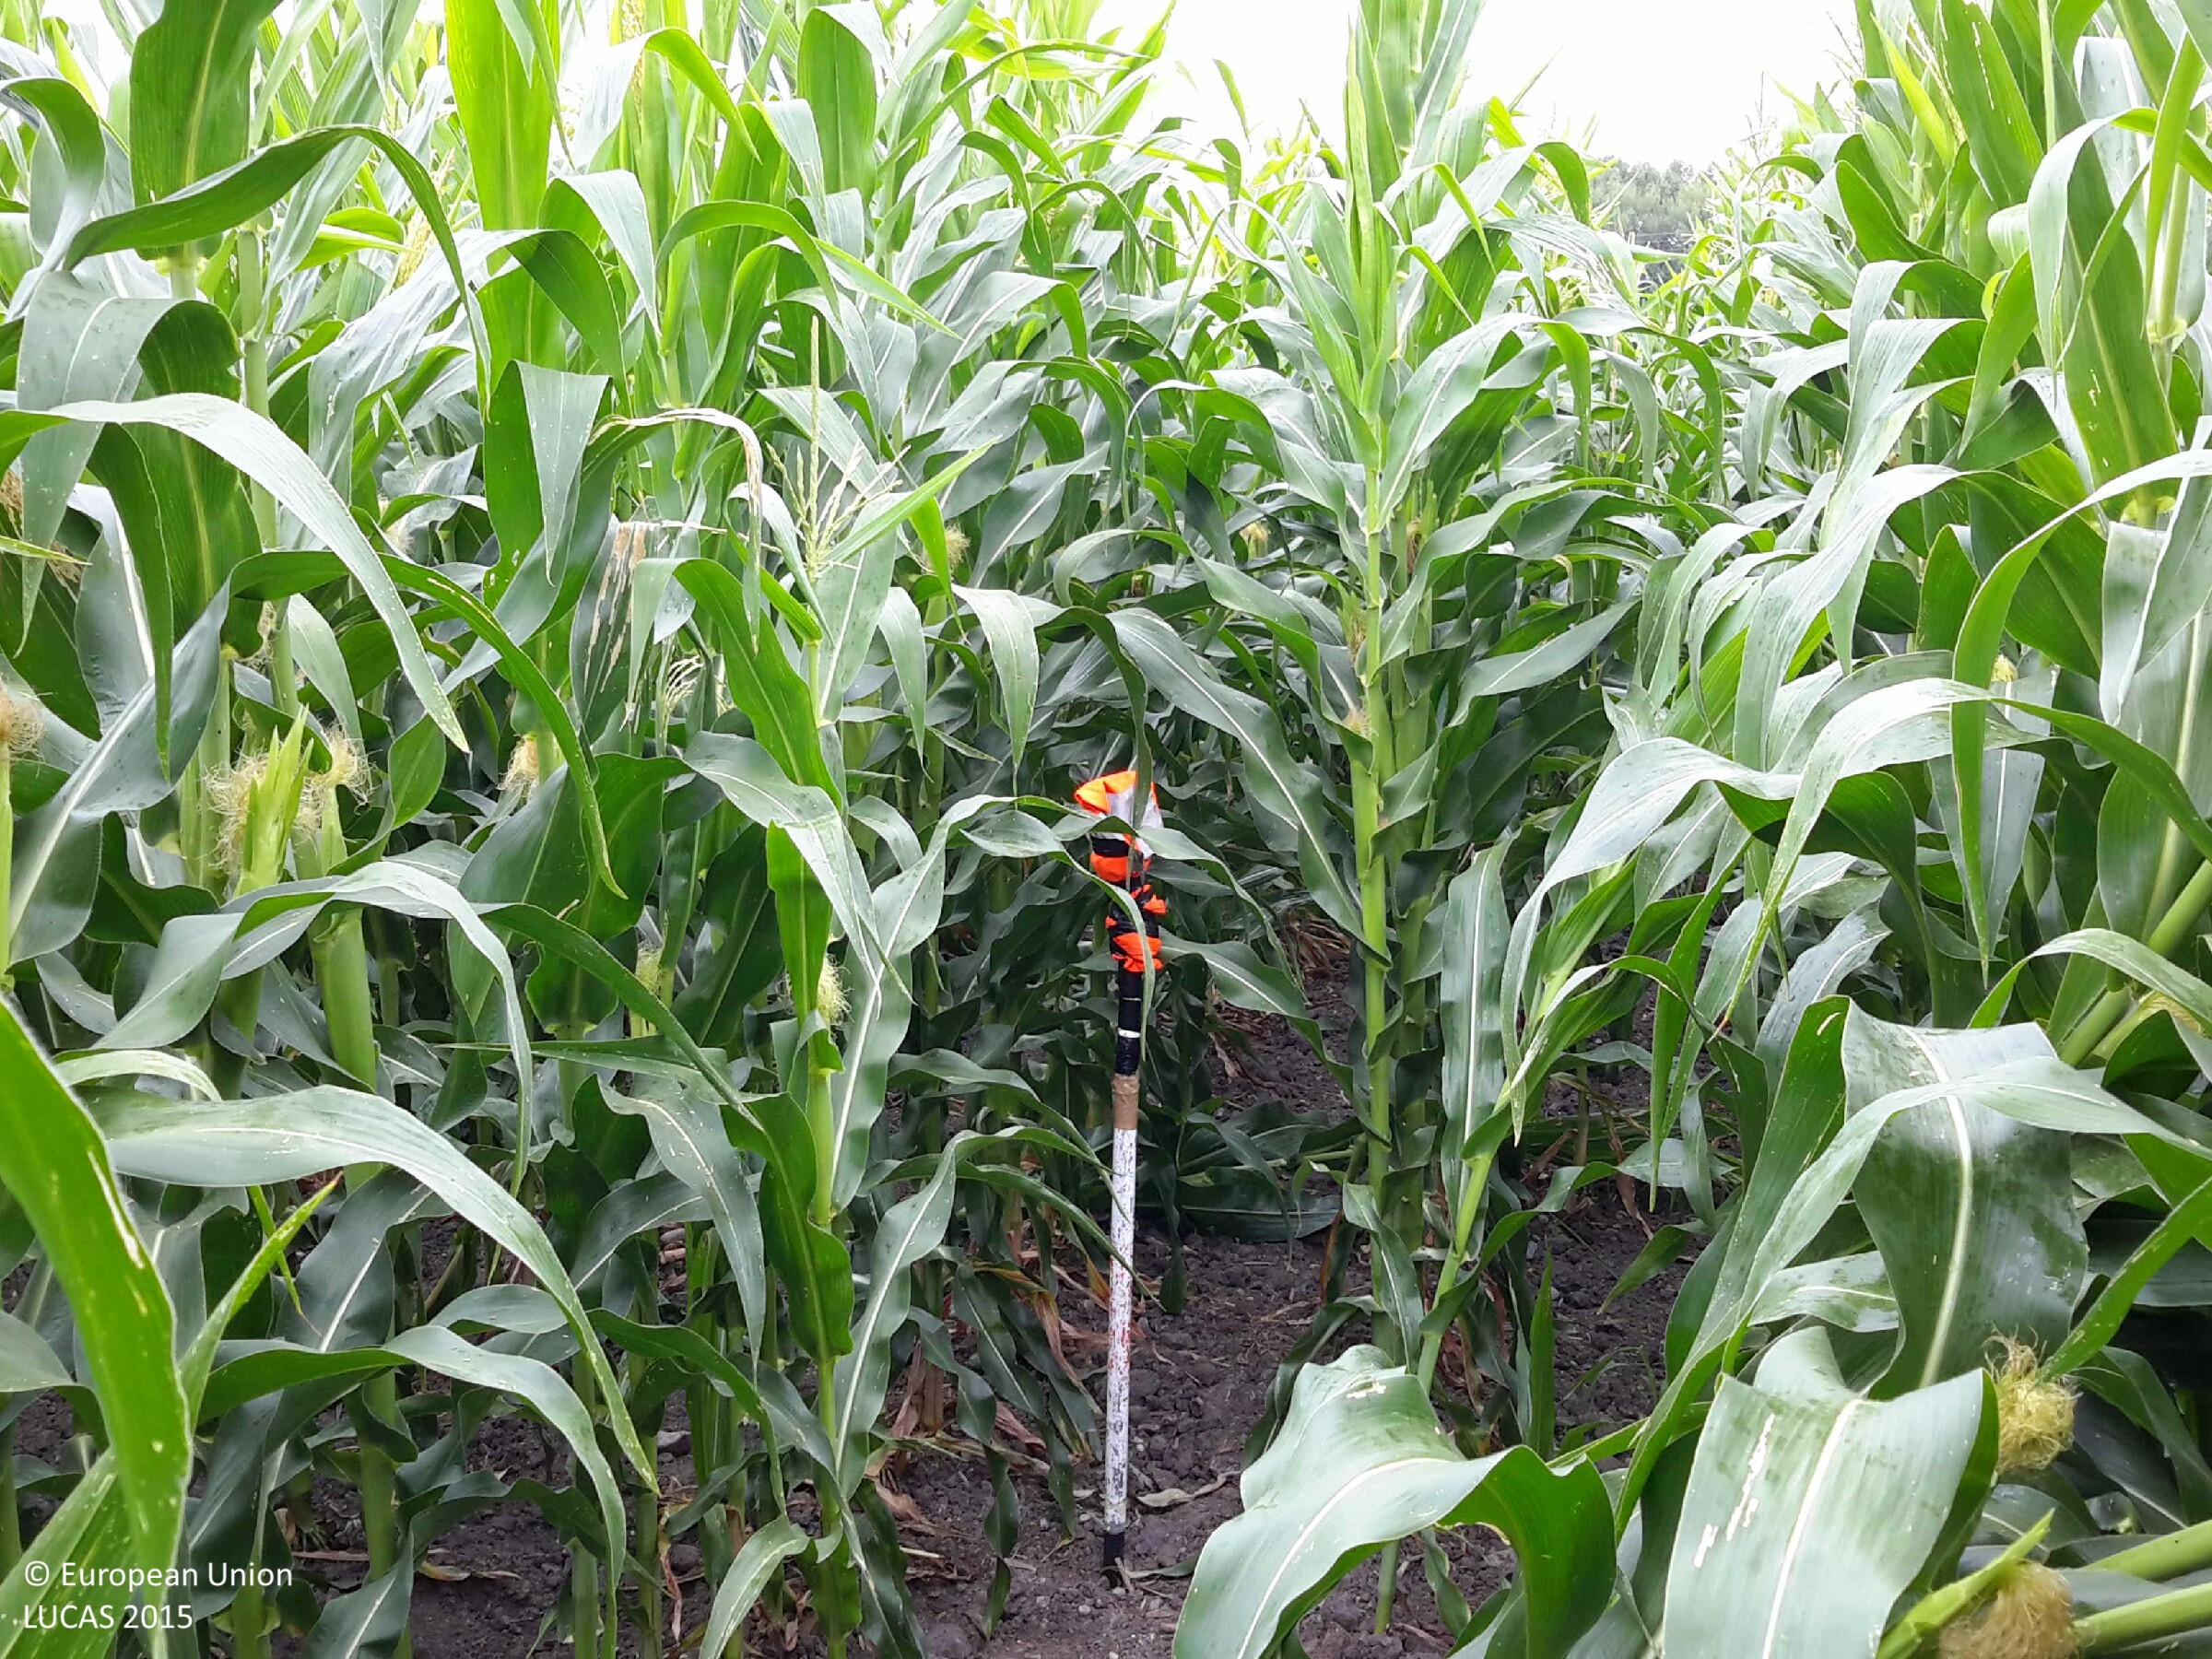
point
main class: Cropland
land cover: Maize
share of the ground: > 75 %
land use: Agriculture (excluding fallow land and kitchen gardens)
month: July
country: HU
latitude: 47.4956
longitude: 17.5346
